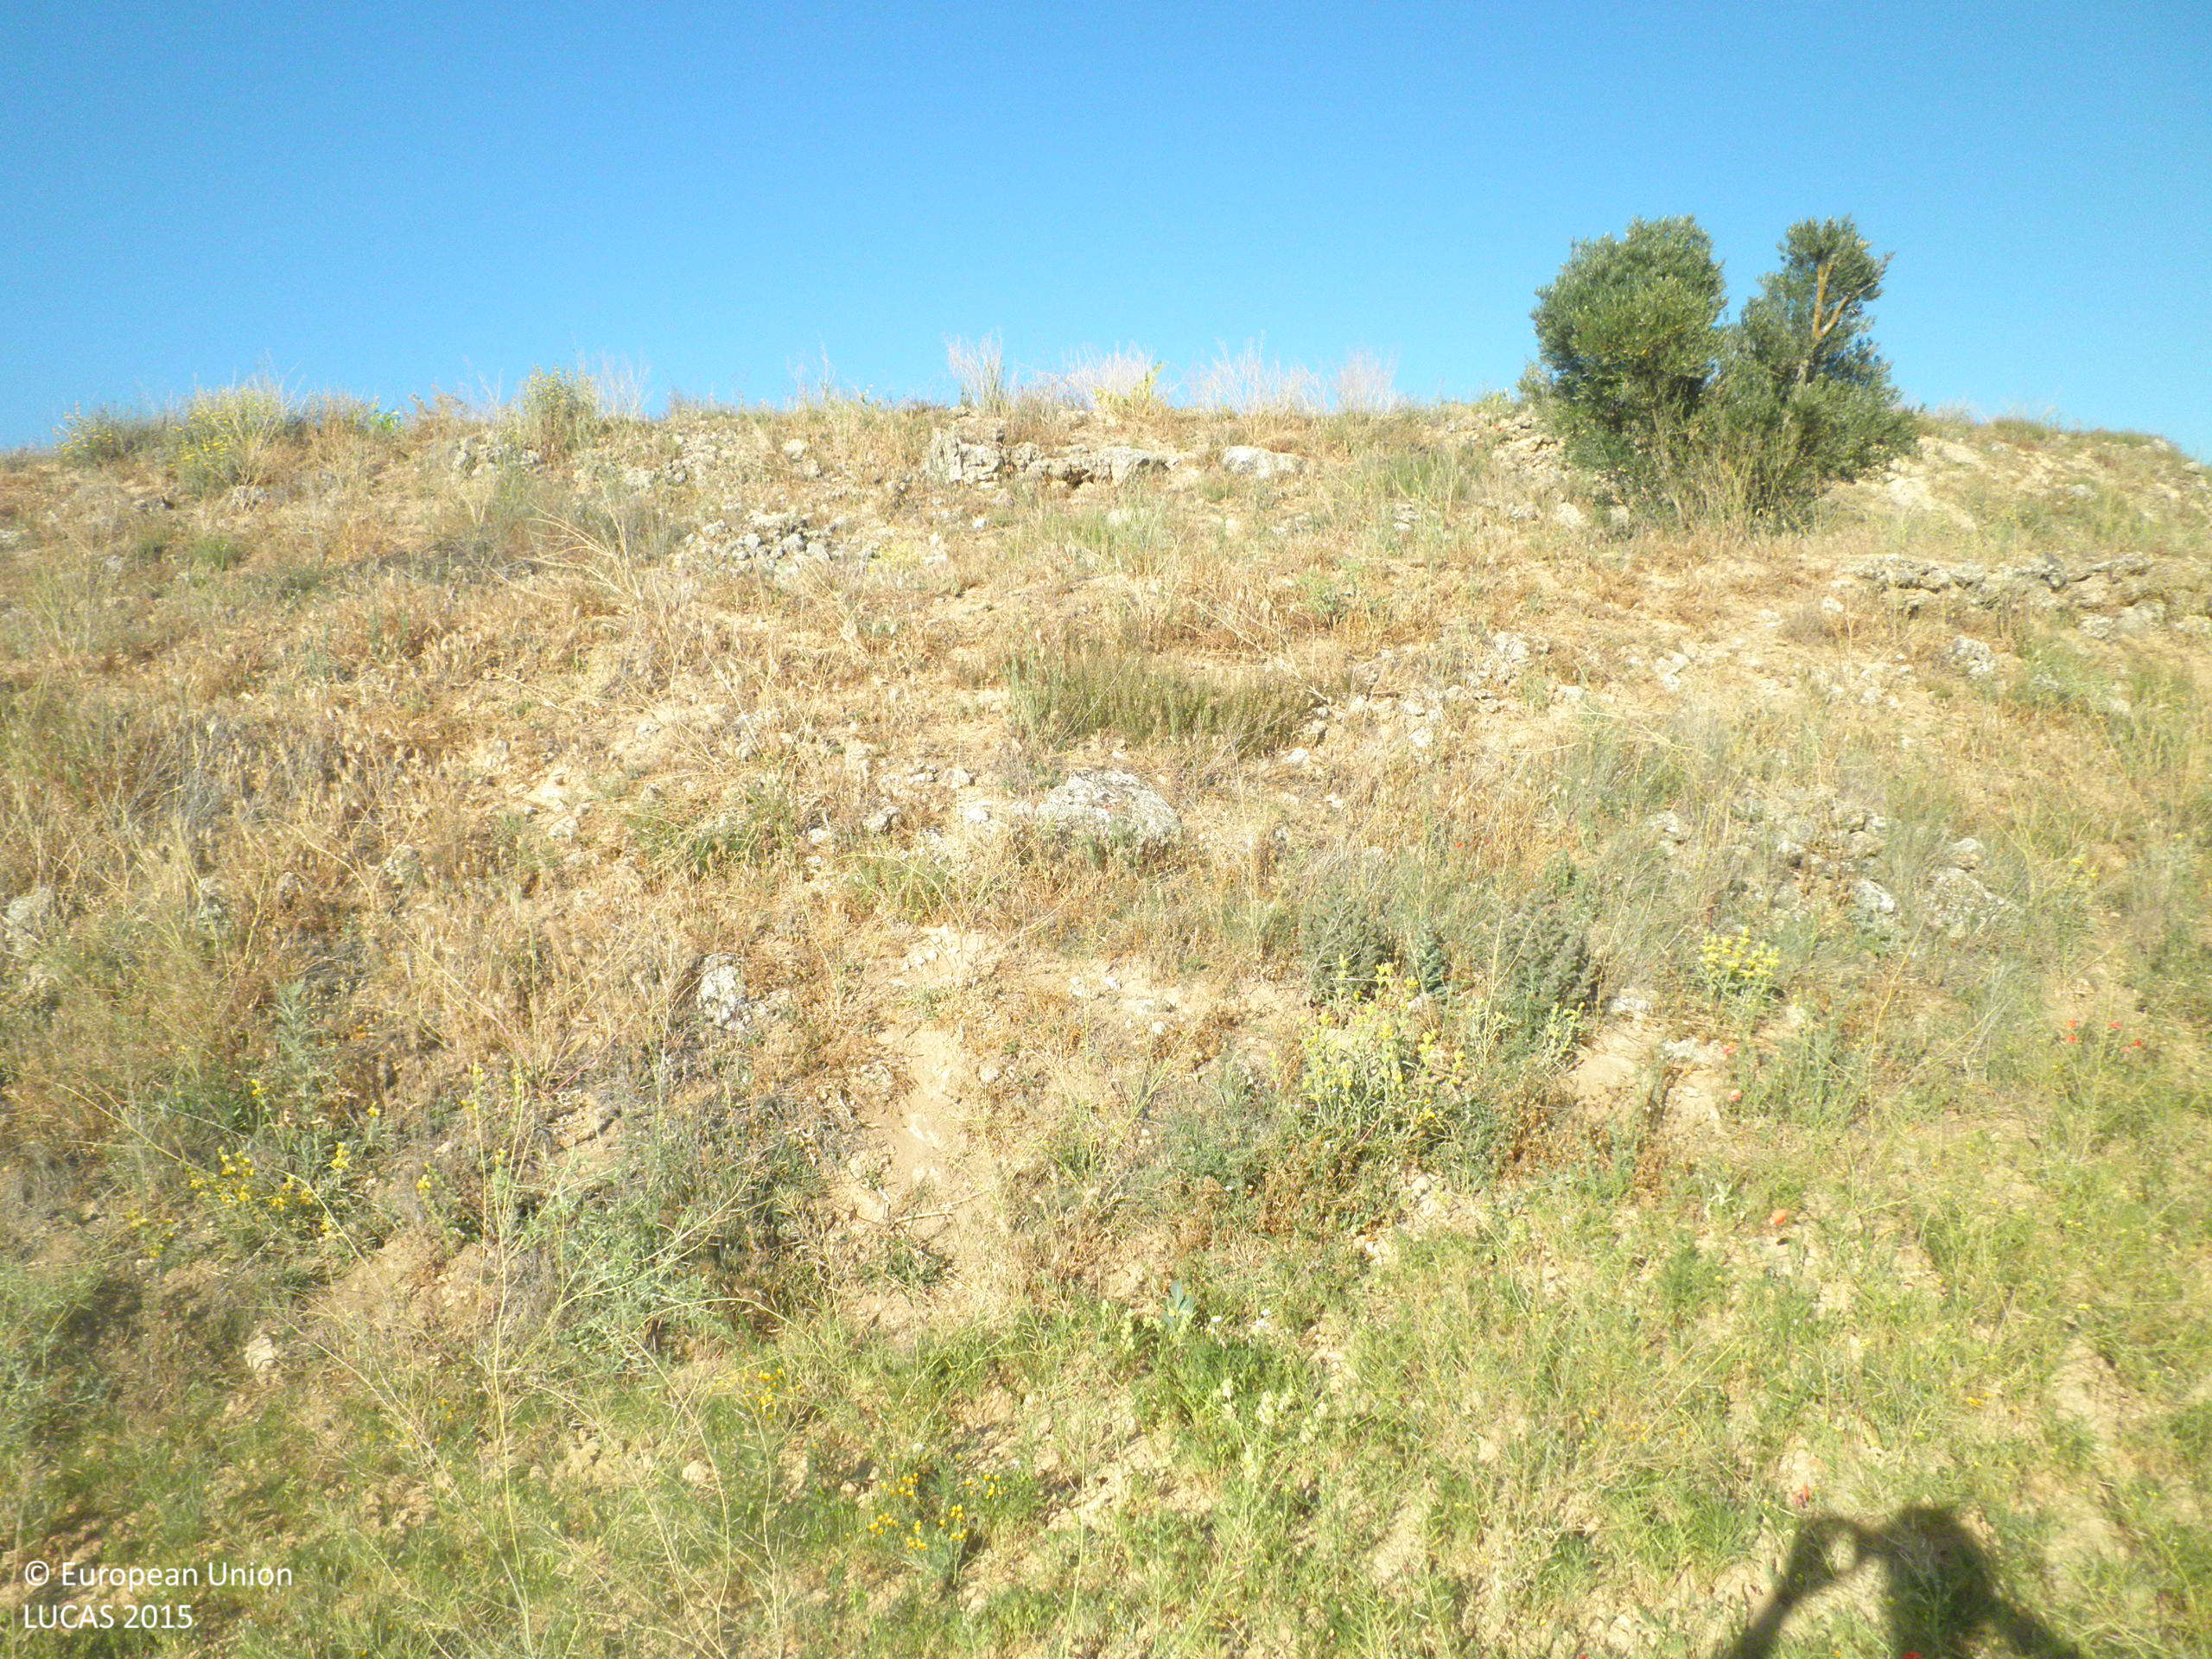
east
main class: Grassland
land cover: Spontaneously vegetated surfaces
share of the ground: > 75 %
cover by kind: herbaceous plants 75 %, unconsolidated bare surface 25 %
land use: Fallow land
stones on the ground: < 10 %
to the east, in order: Spontaneously vegetated surfaces; Grassland without tree/shrub cover; Dry stone walls; Vineyards
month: June
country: ES
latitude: 39.4129
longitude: -1.7470
